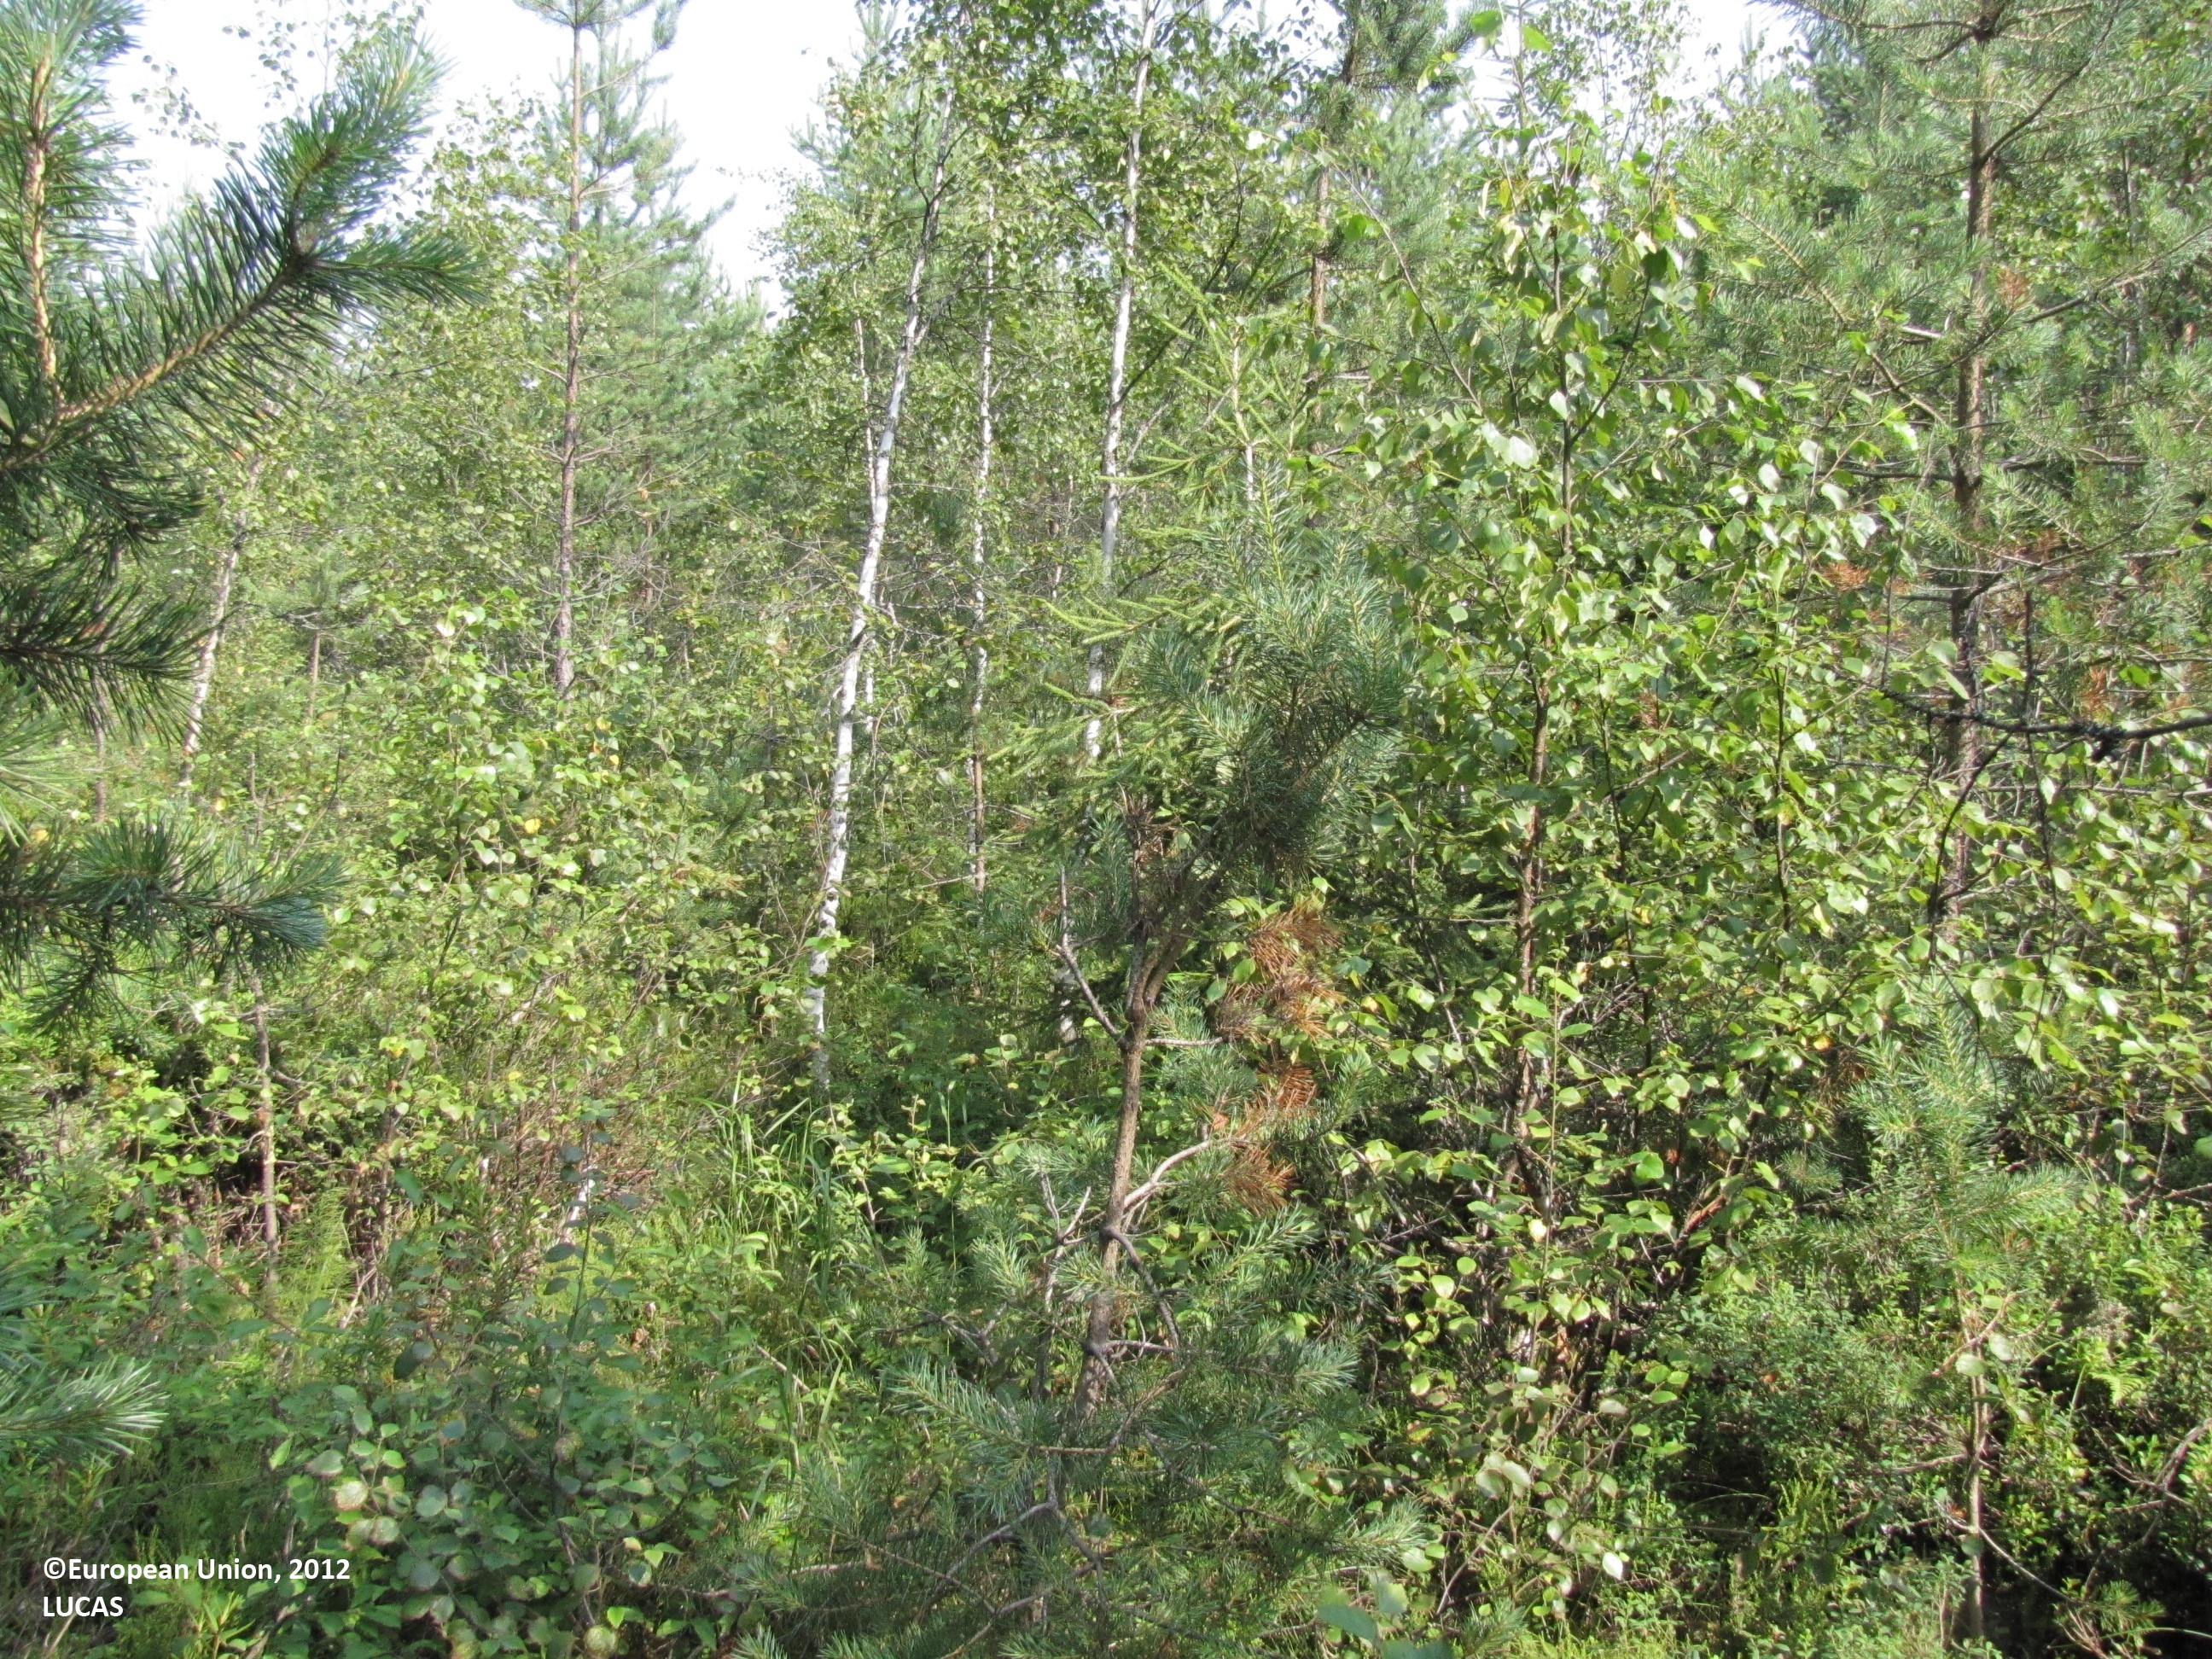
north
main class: Woodland
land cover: Other mixed woodland
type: boreal forest
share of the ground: 50 - 75 %
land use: Forestry
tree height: > 5 m
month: July
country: FI
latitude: 62.0280
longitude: 23.1996
